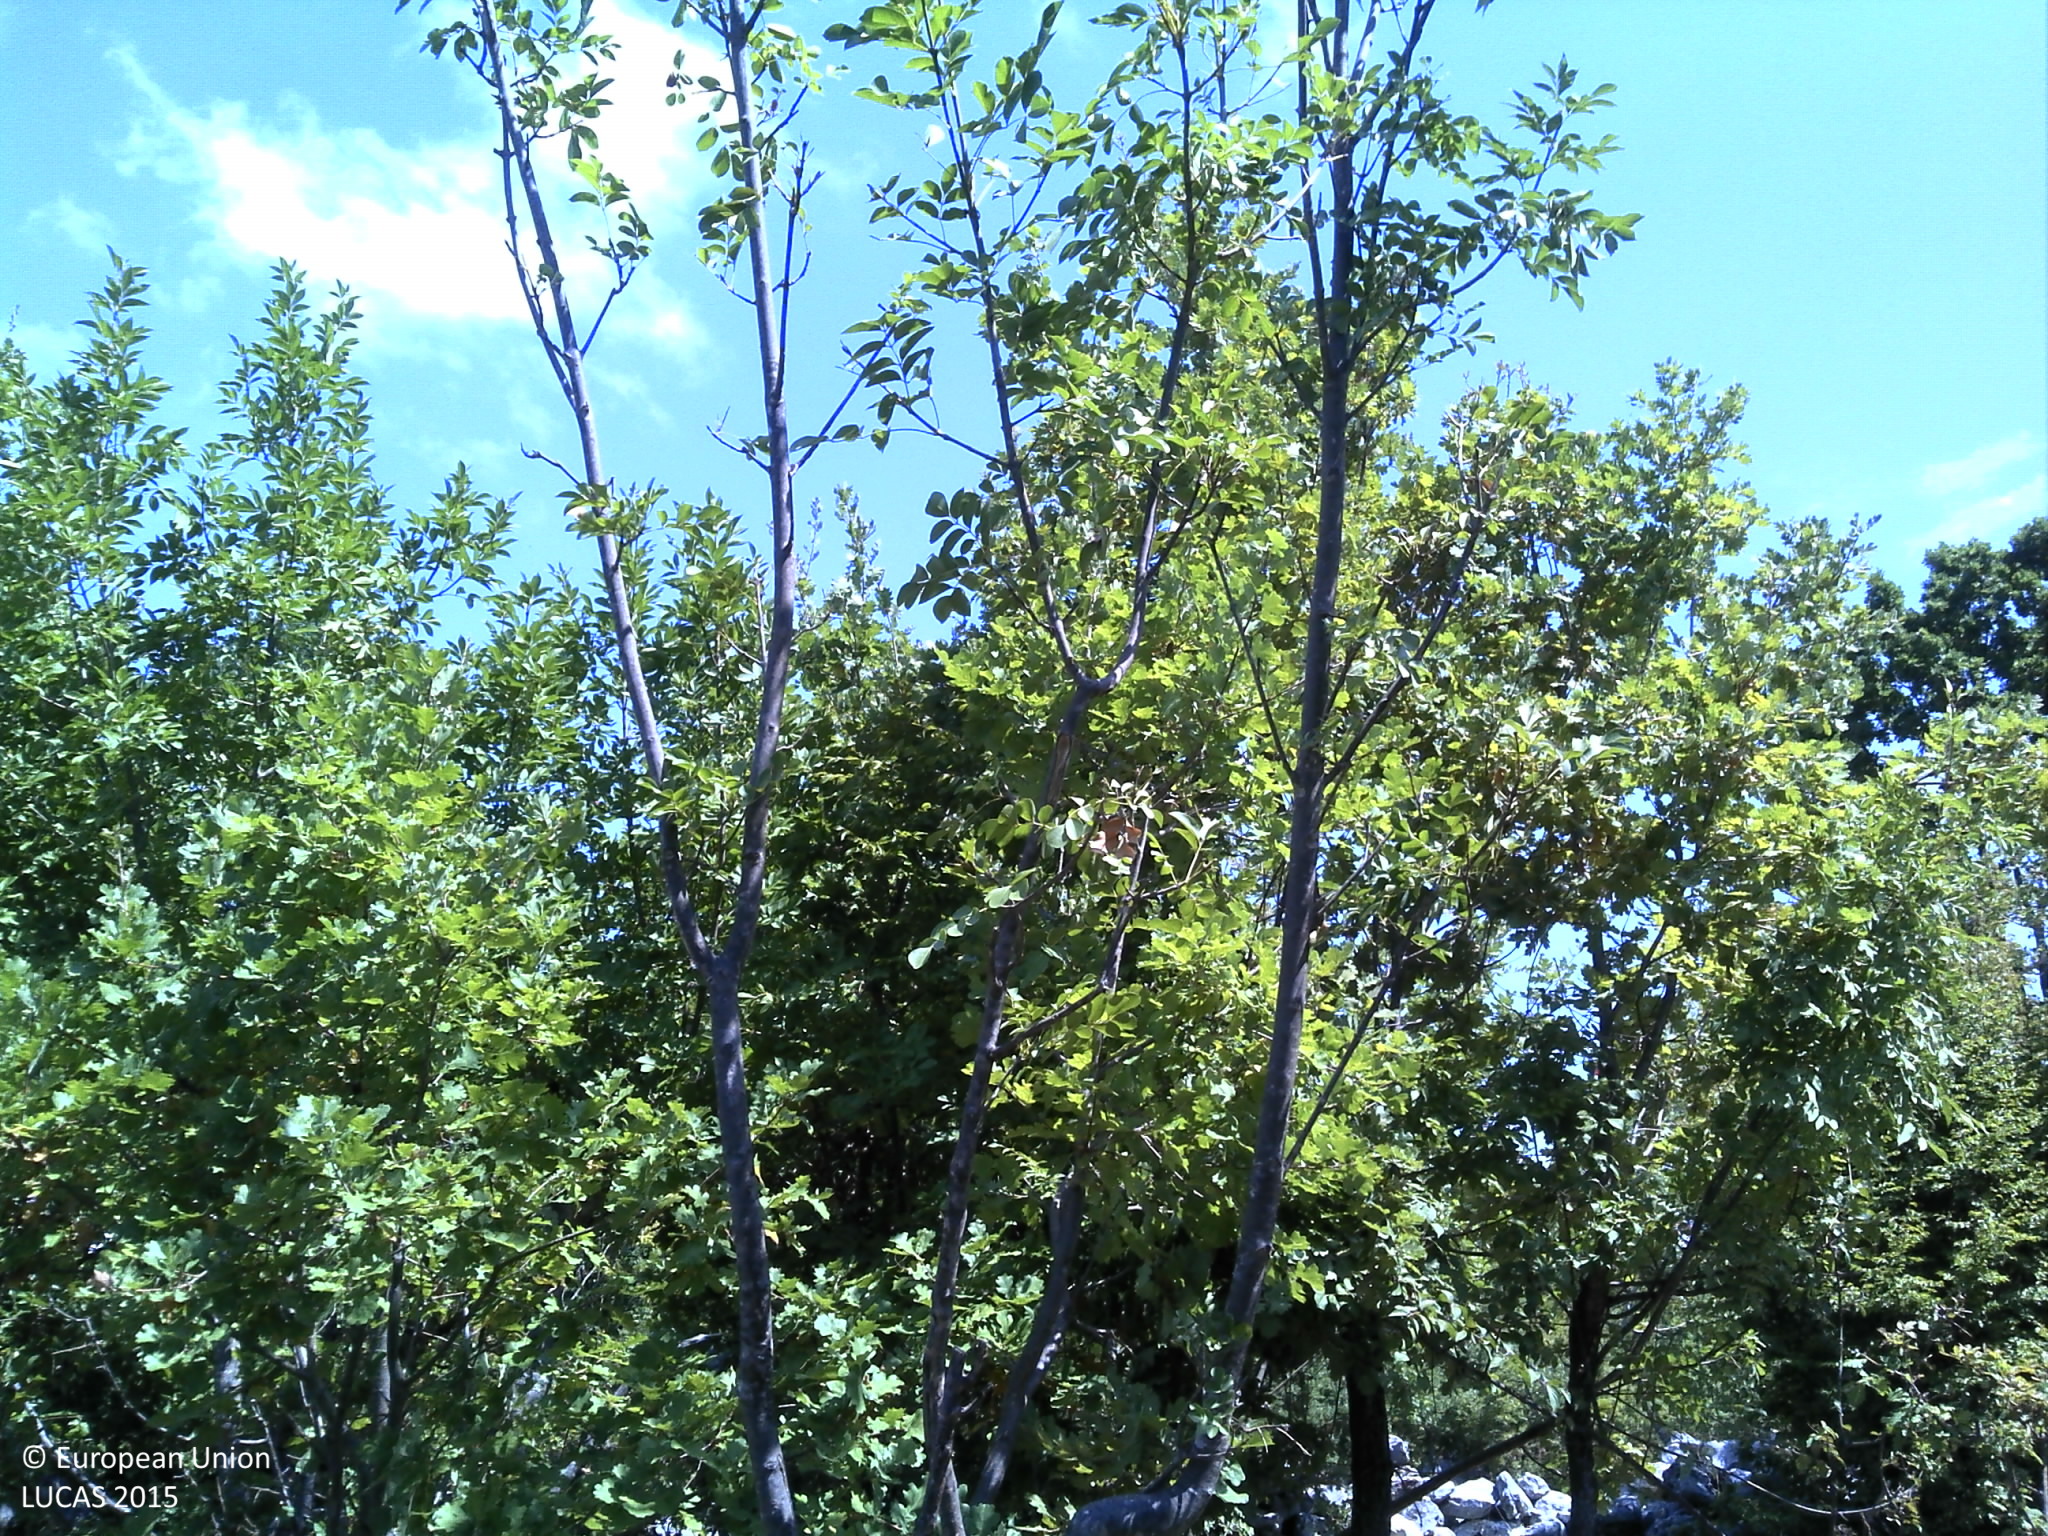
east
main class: Woodland
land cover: Broadleaved woodland
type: thermophilous deciduous forest
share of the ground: 25 - 50 %
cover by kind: broadleaved forest trees 40 %, herbaceous plants 30 %, shrubs 15 %, consolidated bare surface 10 %, unconsolidated bare surface 5 %
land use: Abandoned areas
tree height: > 5 m
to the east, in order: Broadleaved woodland; Rocks and stones; Broadleaved woodland; Dry stone walls; Tracks; Dry stone walls; Shrubland with sparse tree cover; Broadleaved woodland; Dry stone walls; Broadleaved woodland; Tracks; Shrubland with sparse tree cover; Dry stone walls
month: August
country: HR
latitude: 44.1131
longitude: 15.8523
